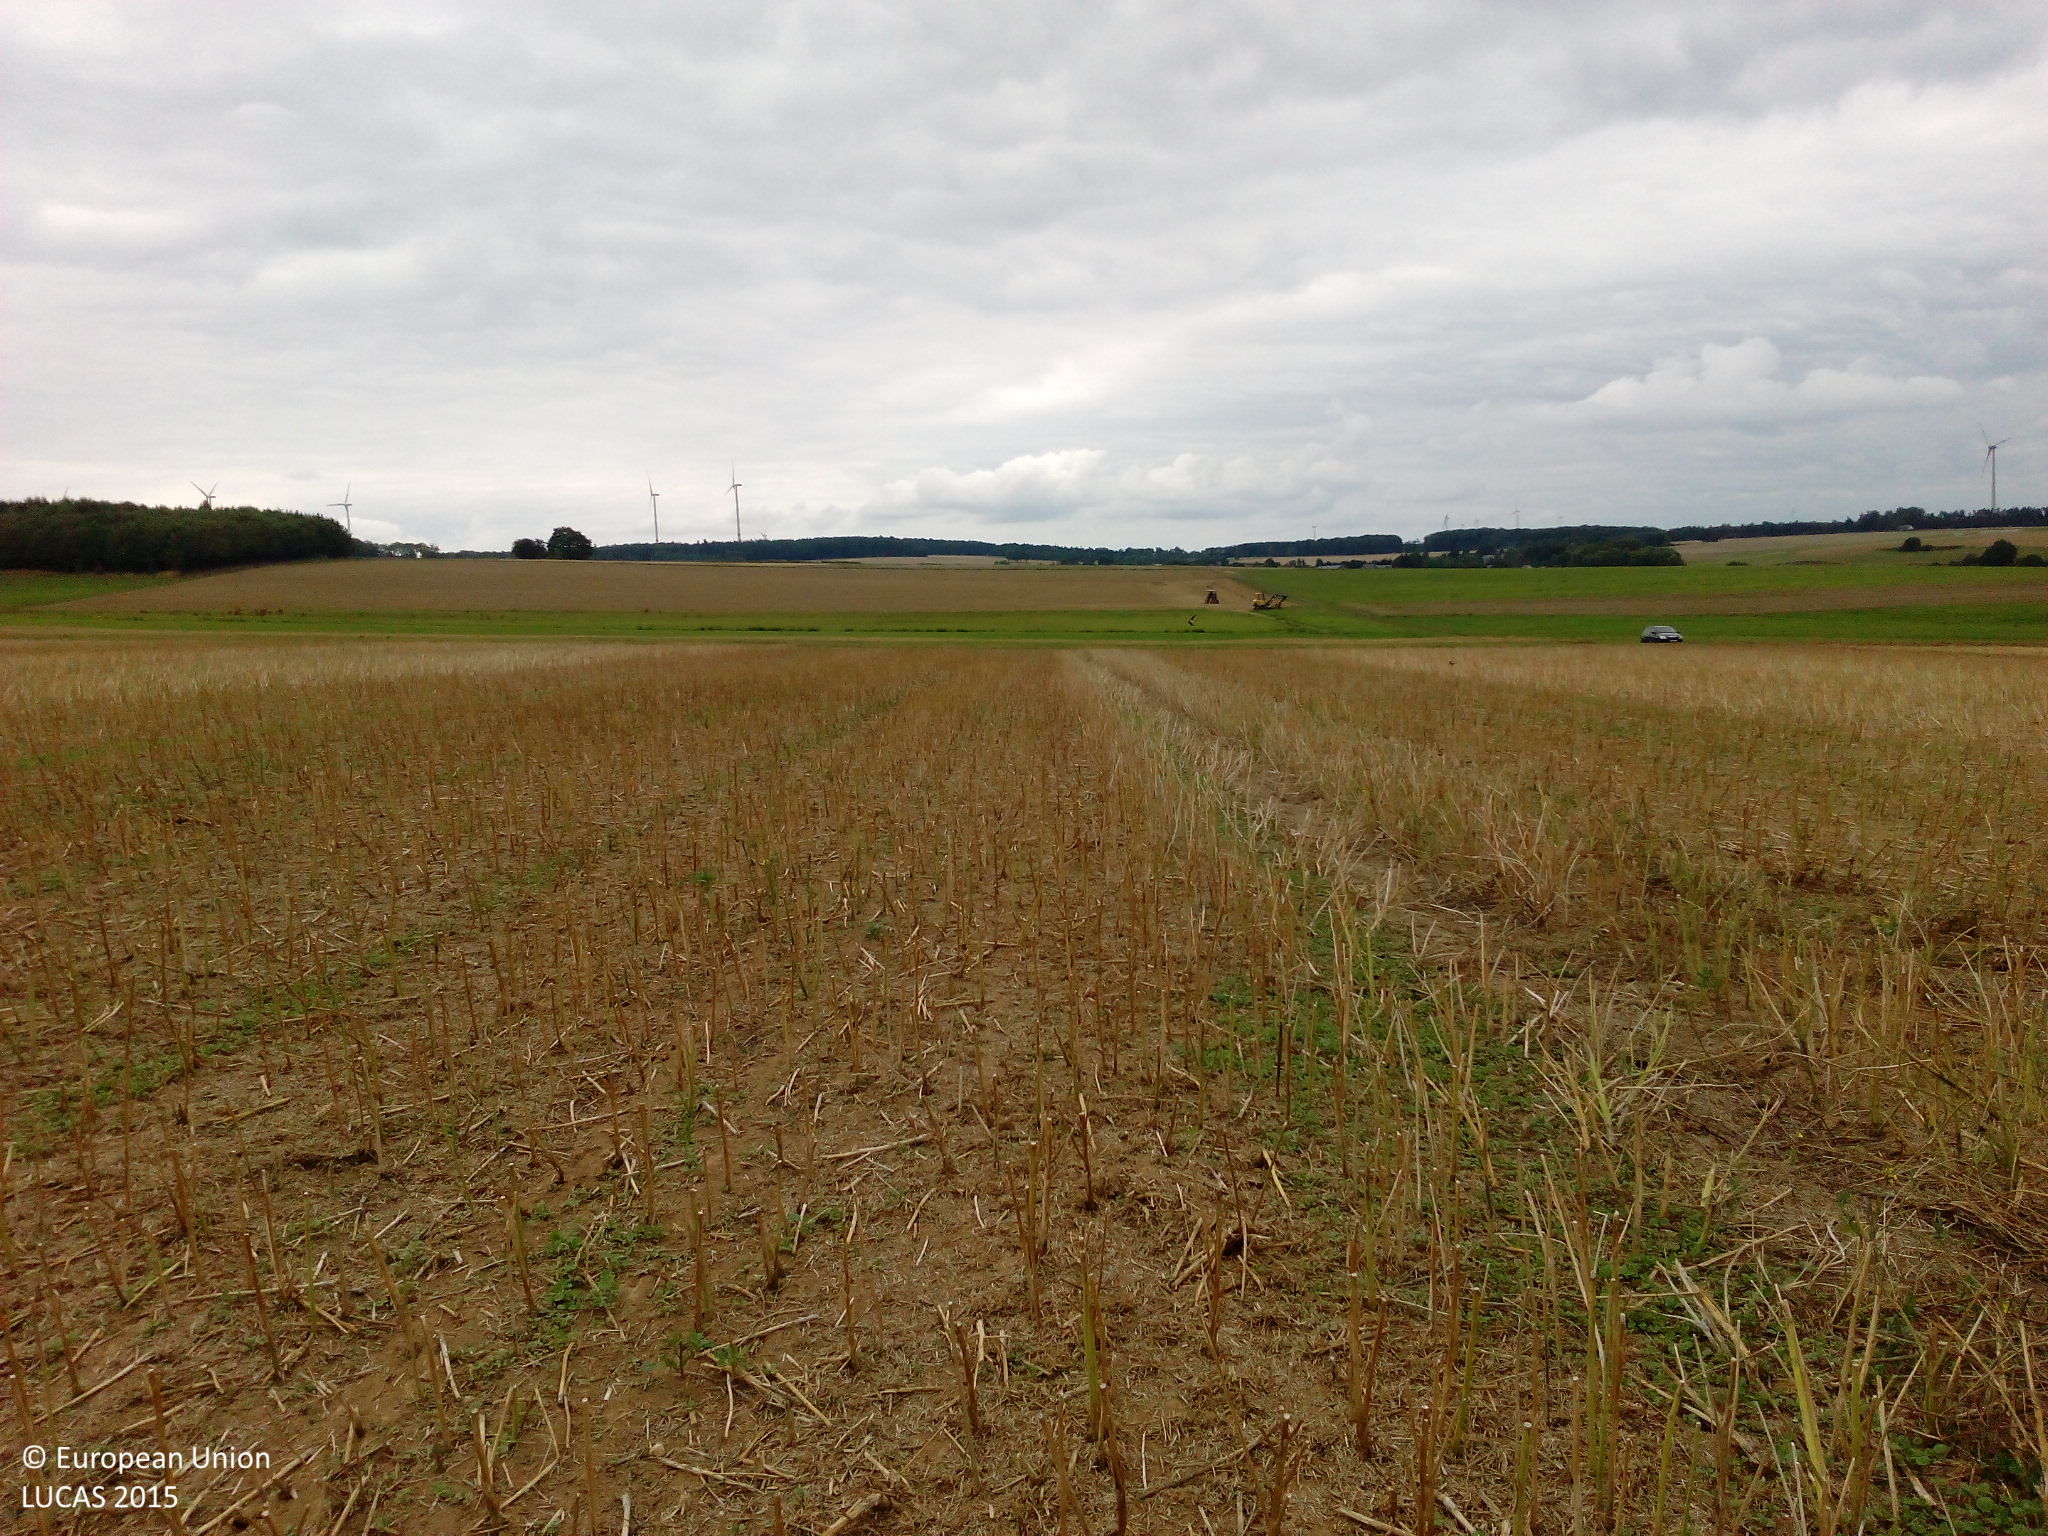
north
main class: Cropland
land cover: Rape and turnip rape
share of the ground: < 10 %
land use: Agriculture (excluding fallow land and kitchen gardens)
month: August
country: DE
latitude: 50.0136
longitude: 7.5303
